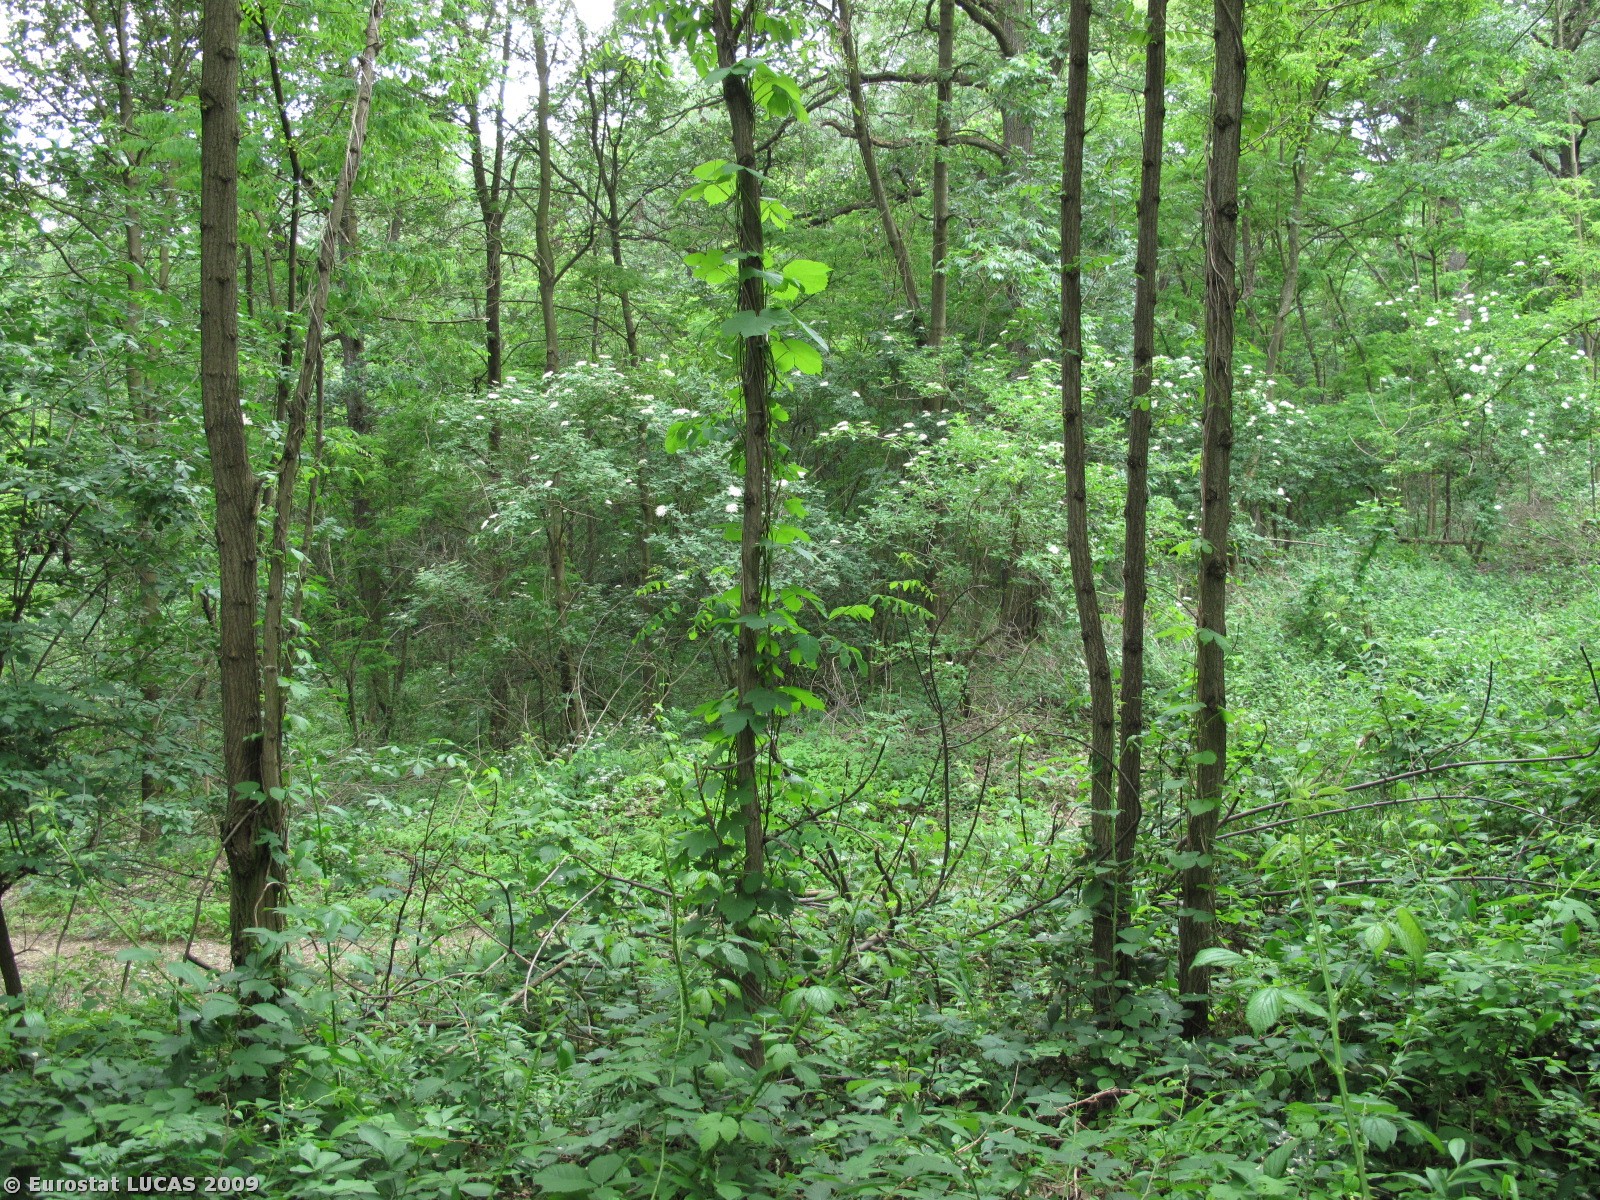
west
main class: Woodland
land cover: Broadleaved woodland
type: mesophytic deciduous forest
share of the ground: 50 - 75 %
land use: Forestry
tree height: > 5 m
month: May
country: AT
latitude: 48.5276
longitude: 16.0301
